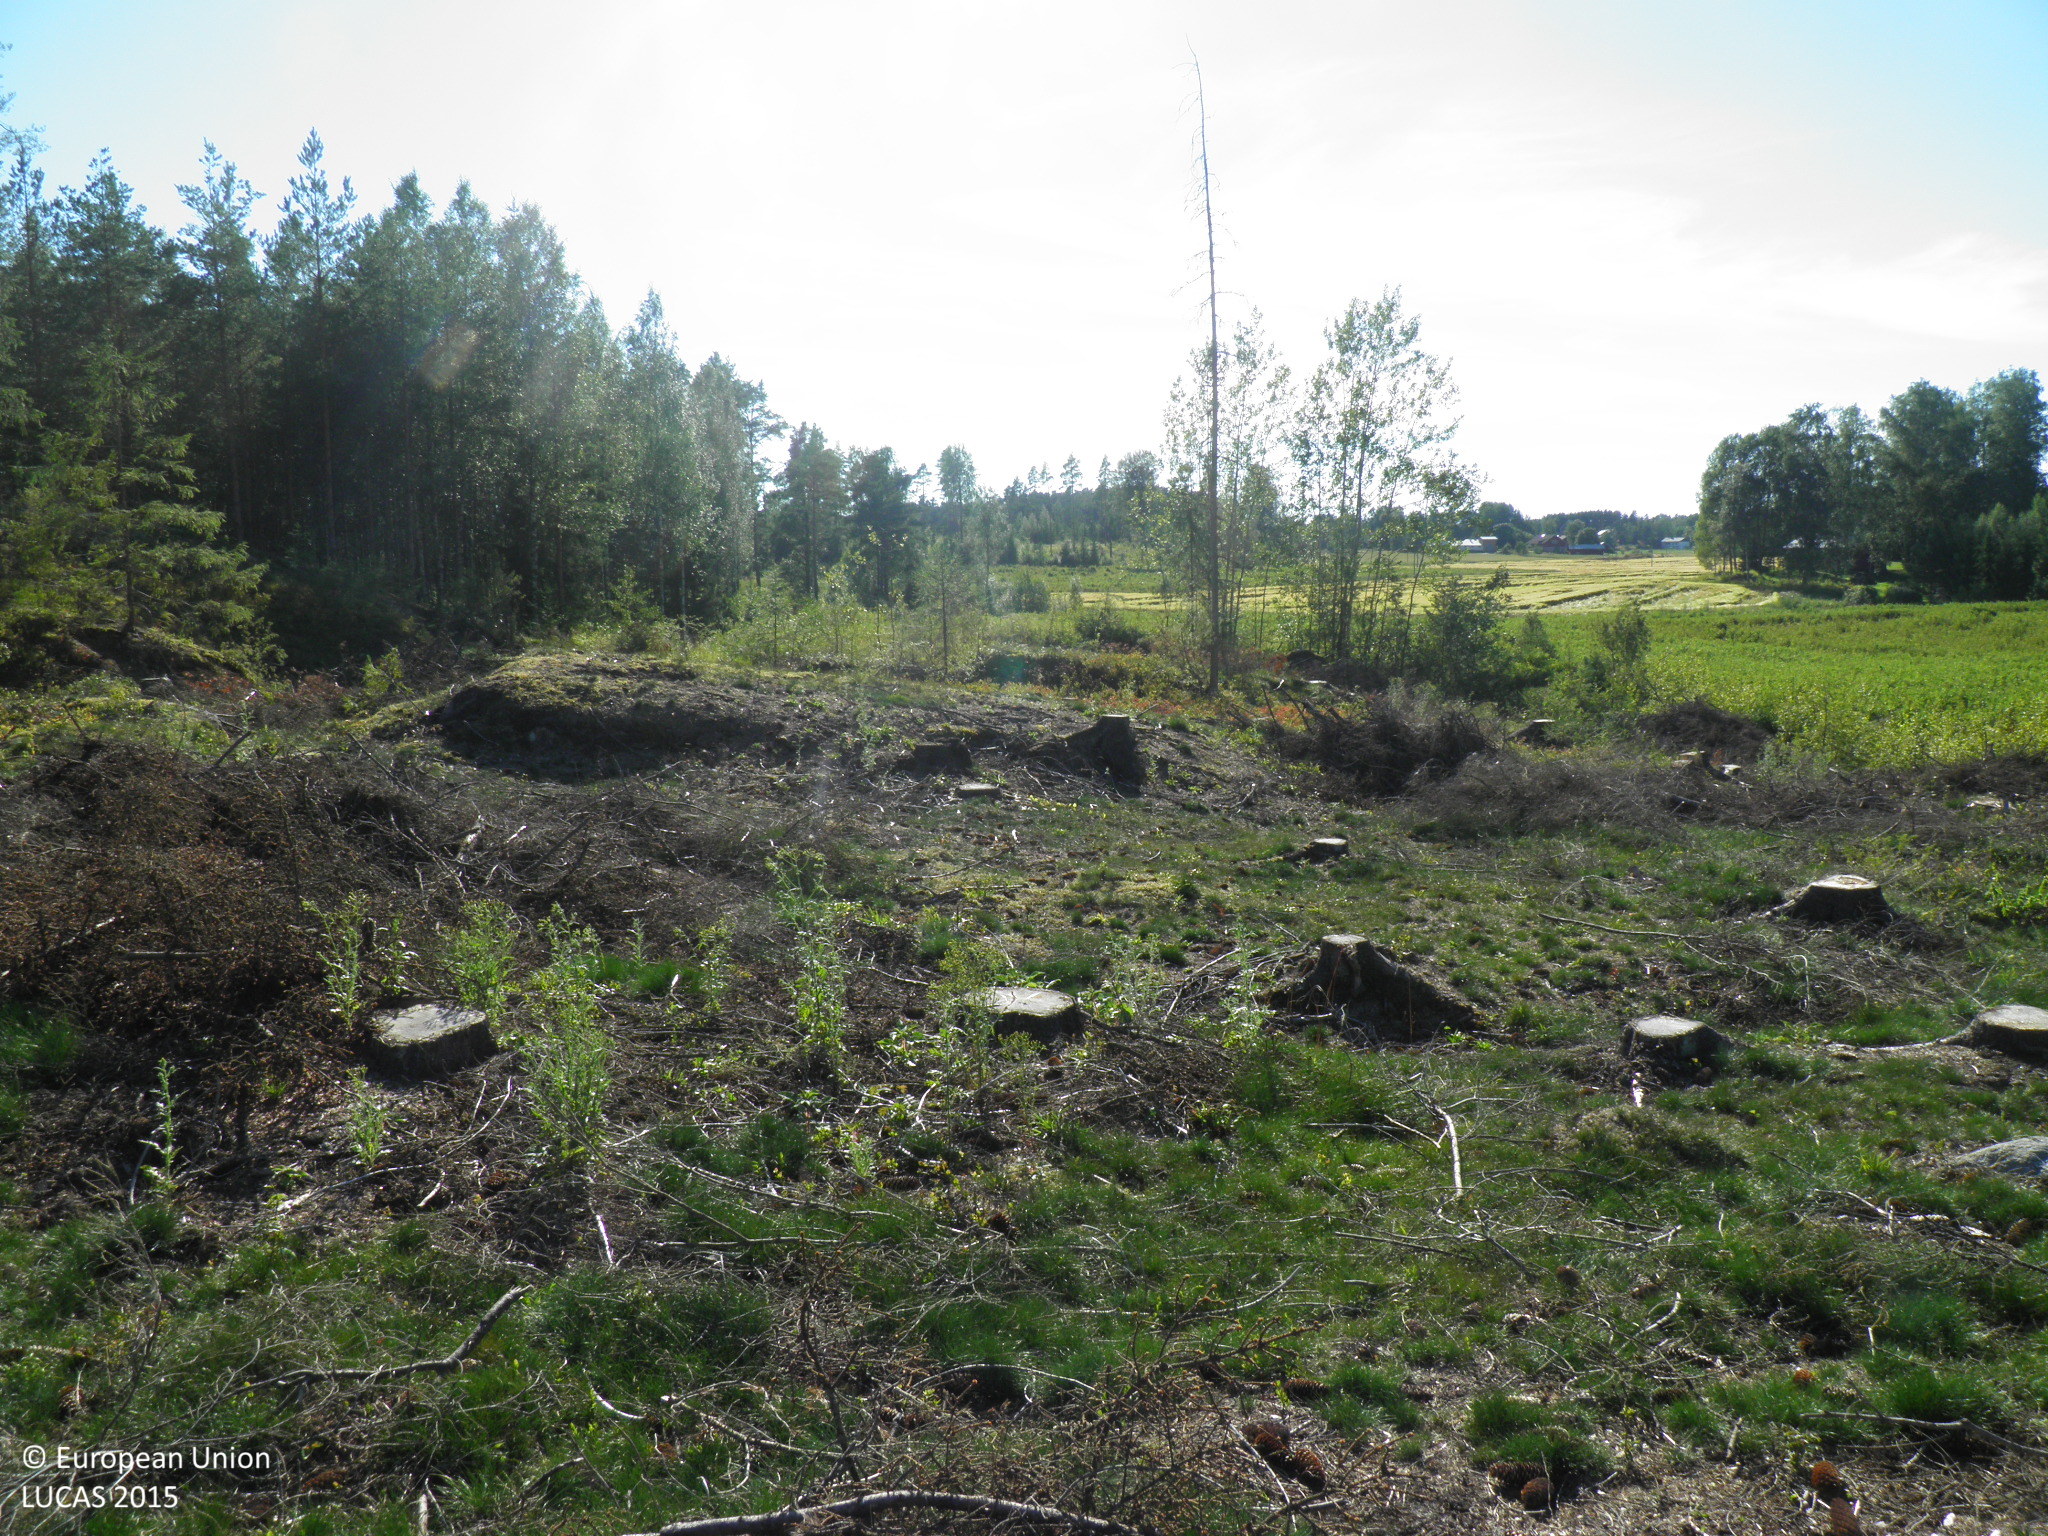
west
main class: Grassland
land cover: Spontaneously vegetated surfaces
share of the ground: 10 - 25 %
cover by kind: unconsolidated bare surface 40 %, herbaceous plants 15 %, shrubs 5 %
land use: Forestry
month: August
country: FI
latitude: 60.7103
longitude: 21.7309
